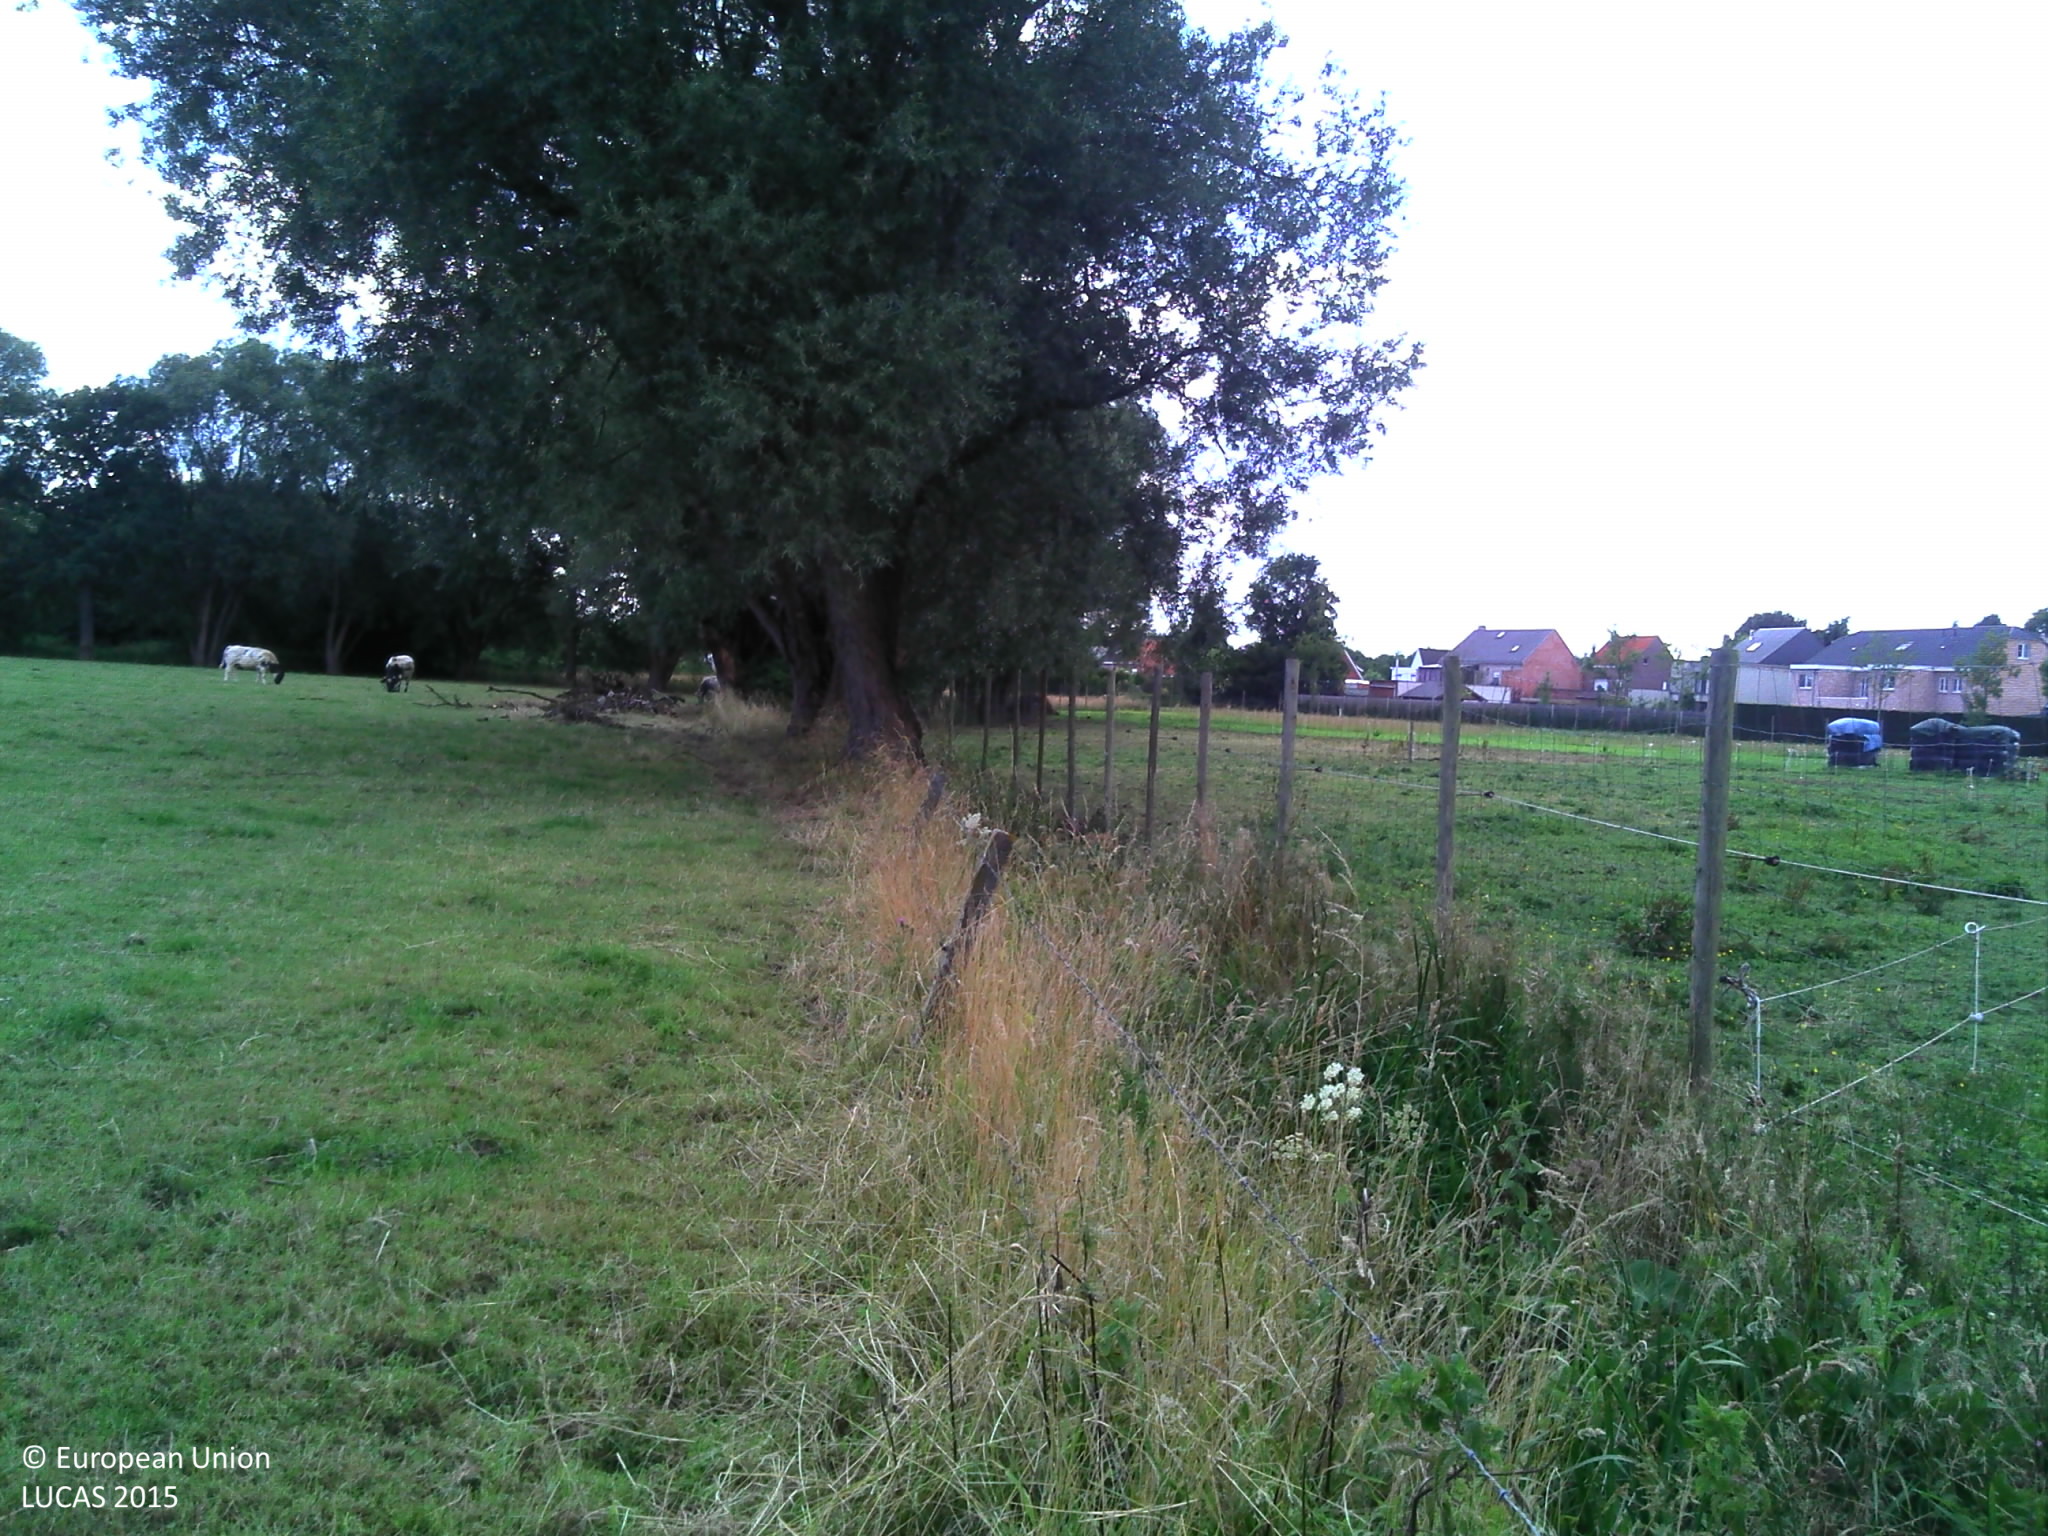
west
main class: Grassland
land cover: Grassland without tree/shrub cover
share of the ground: > 75 %
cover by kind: herbaceous plants 100 %
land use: Agriculture (excluding fallow land and kitchen gardens)
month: July
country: BE
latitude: 51.0981
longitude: 4.5266
